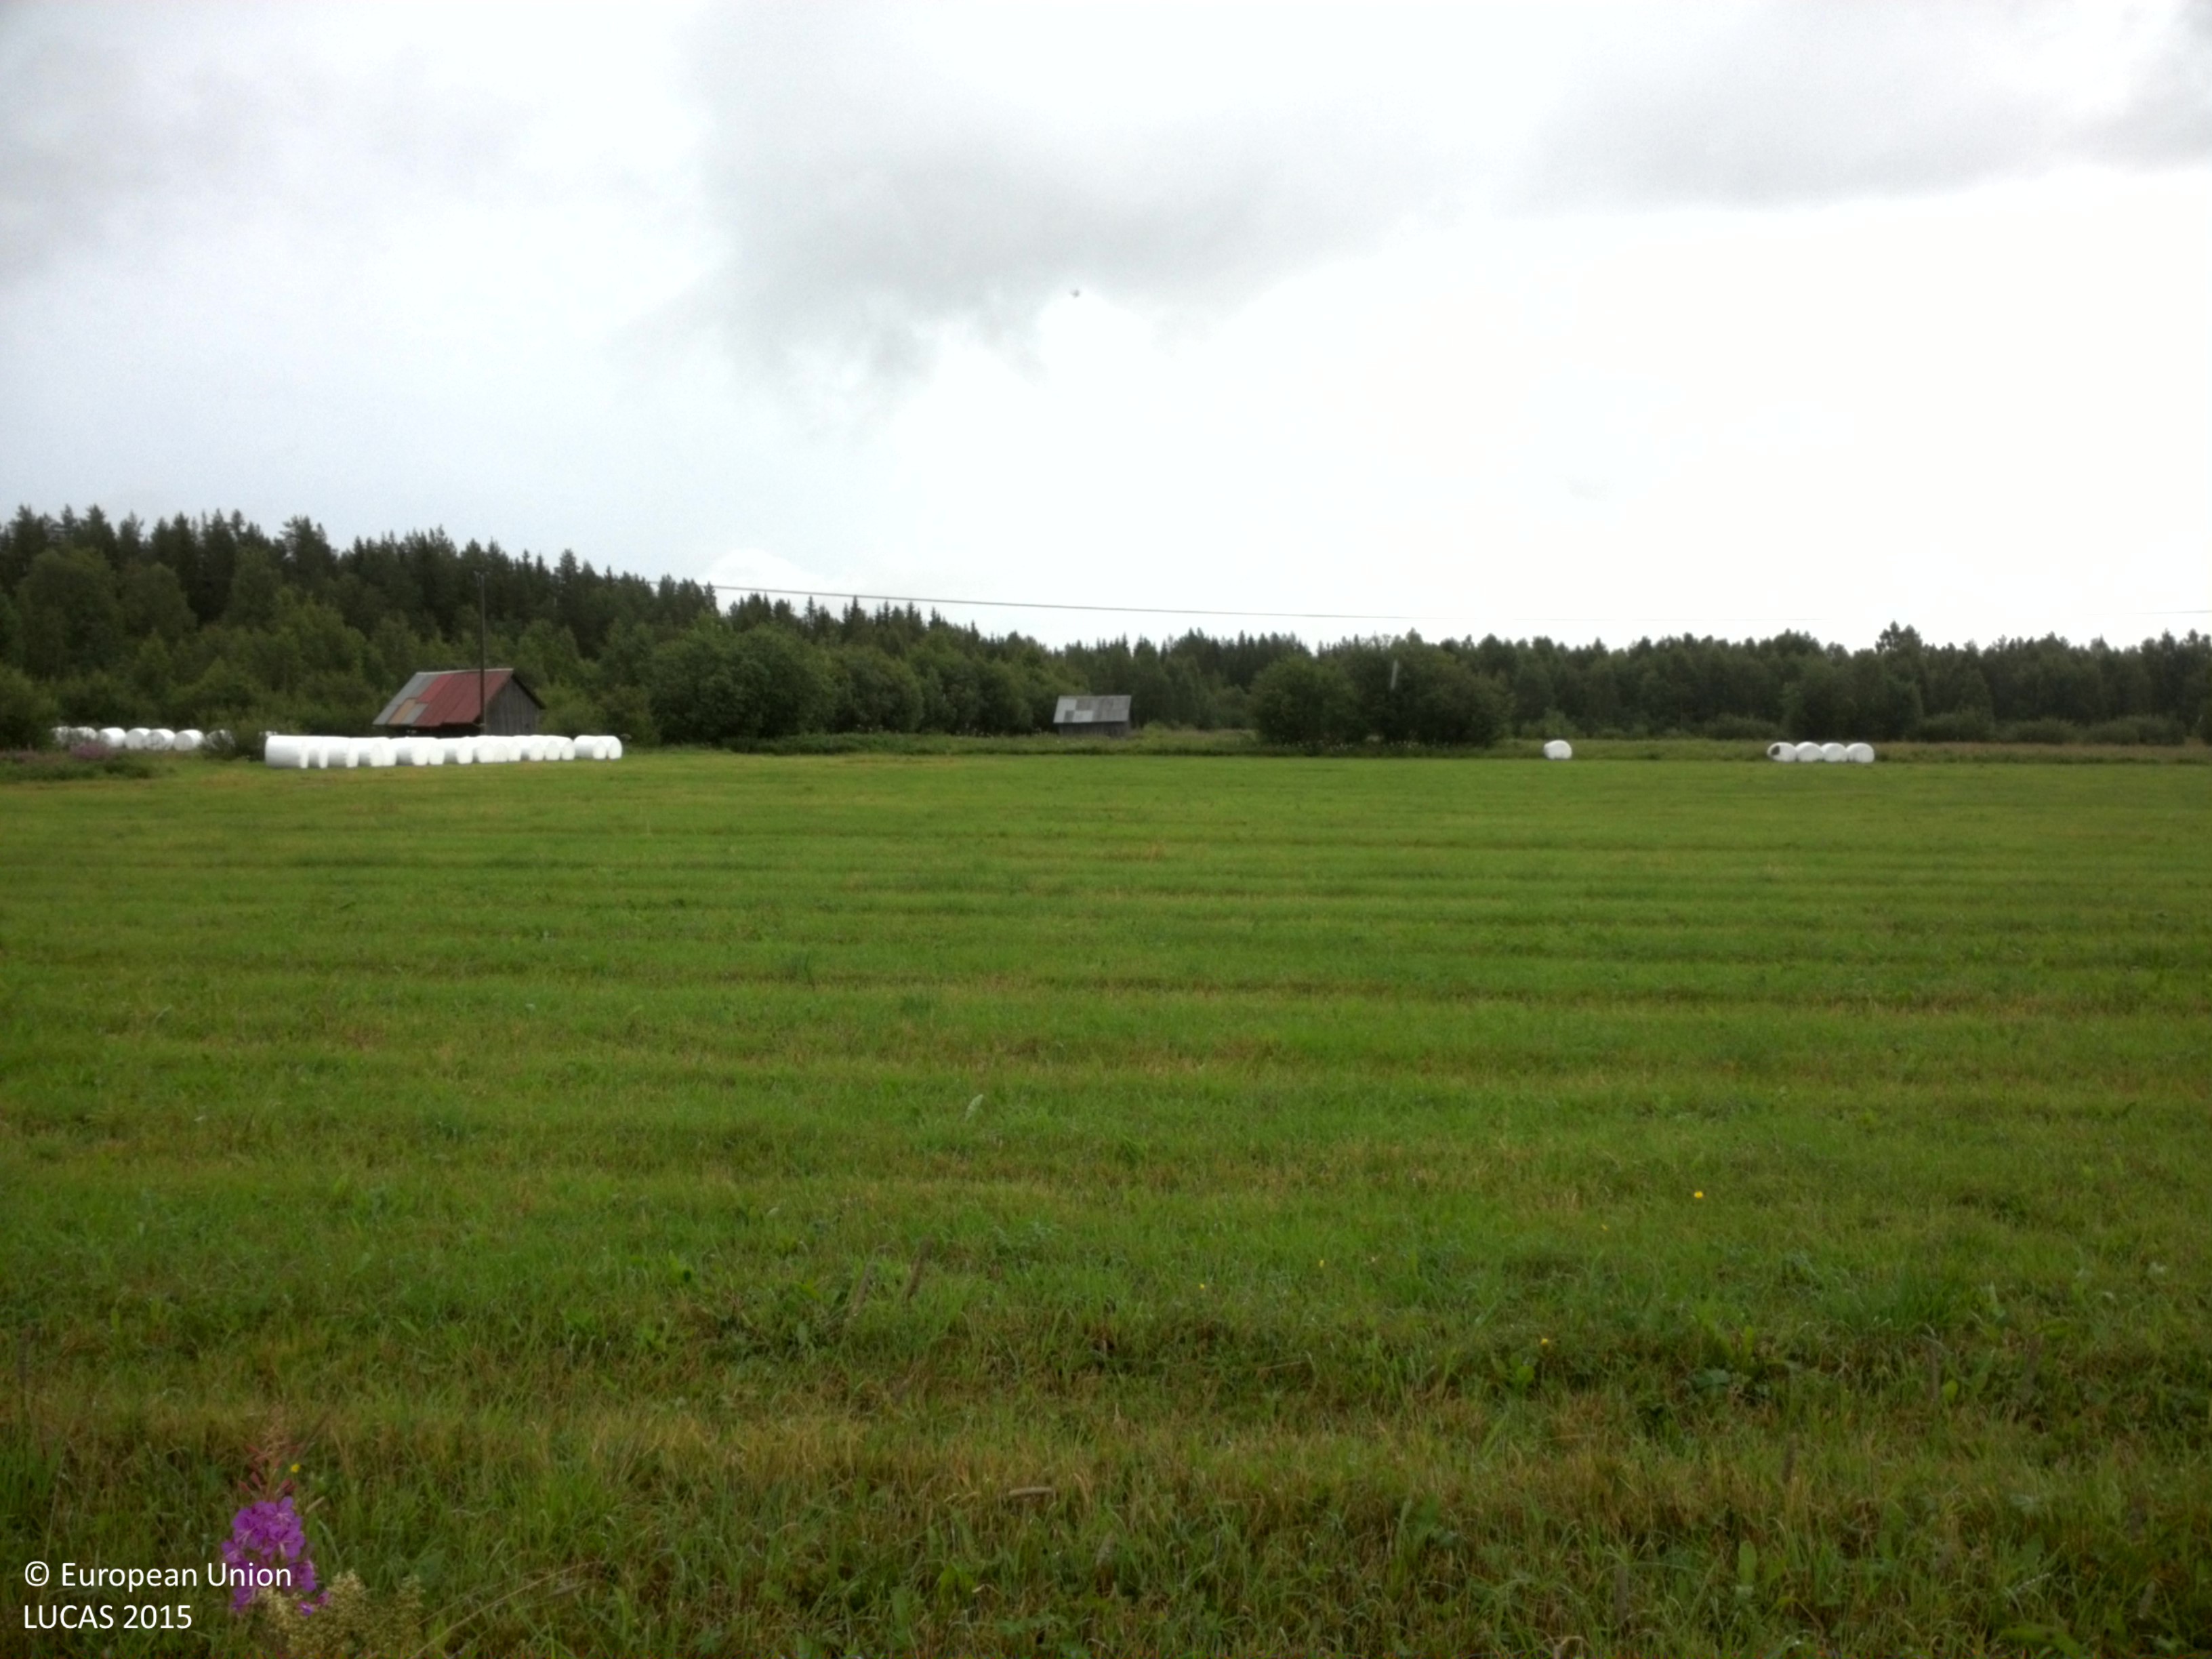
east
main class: Cropland
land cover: Barley
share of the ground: > 75 %
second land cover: Rye
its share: 25 - 50 %
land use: Agriculture (excluding fallow land and kitchen gardens)
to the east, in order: Barley; Rye; Ditches and canals; Grassland without tree/shrub cover; Ditches and canals; Grassland without tree/shrub cover; Abandoned hedges; Ditches and canals; Abandoned hedges; Broadleaved woodland; Grassland without tree/shrub cover; Ditches and canals; Grassland without tree/shrub cover; Tracks; Grassland without tree/shrub cover
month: August
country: SE
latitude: 64.6563
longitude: 20.9716
